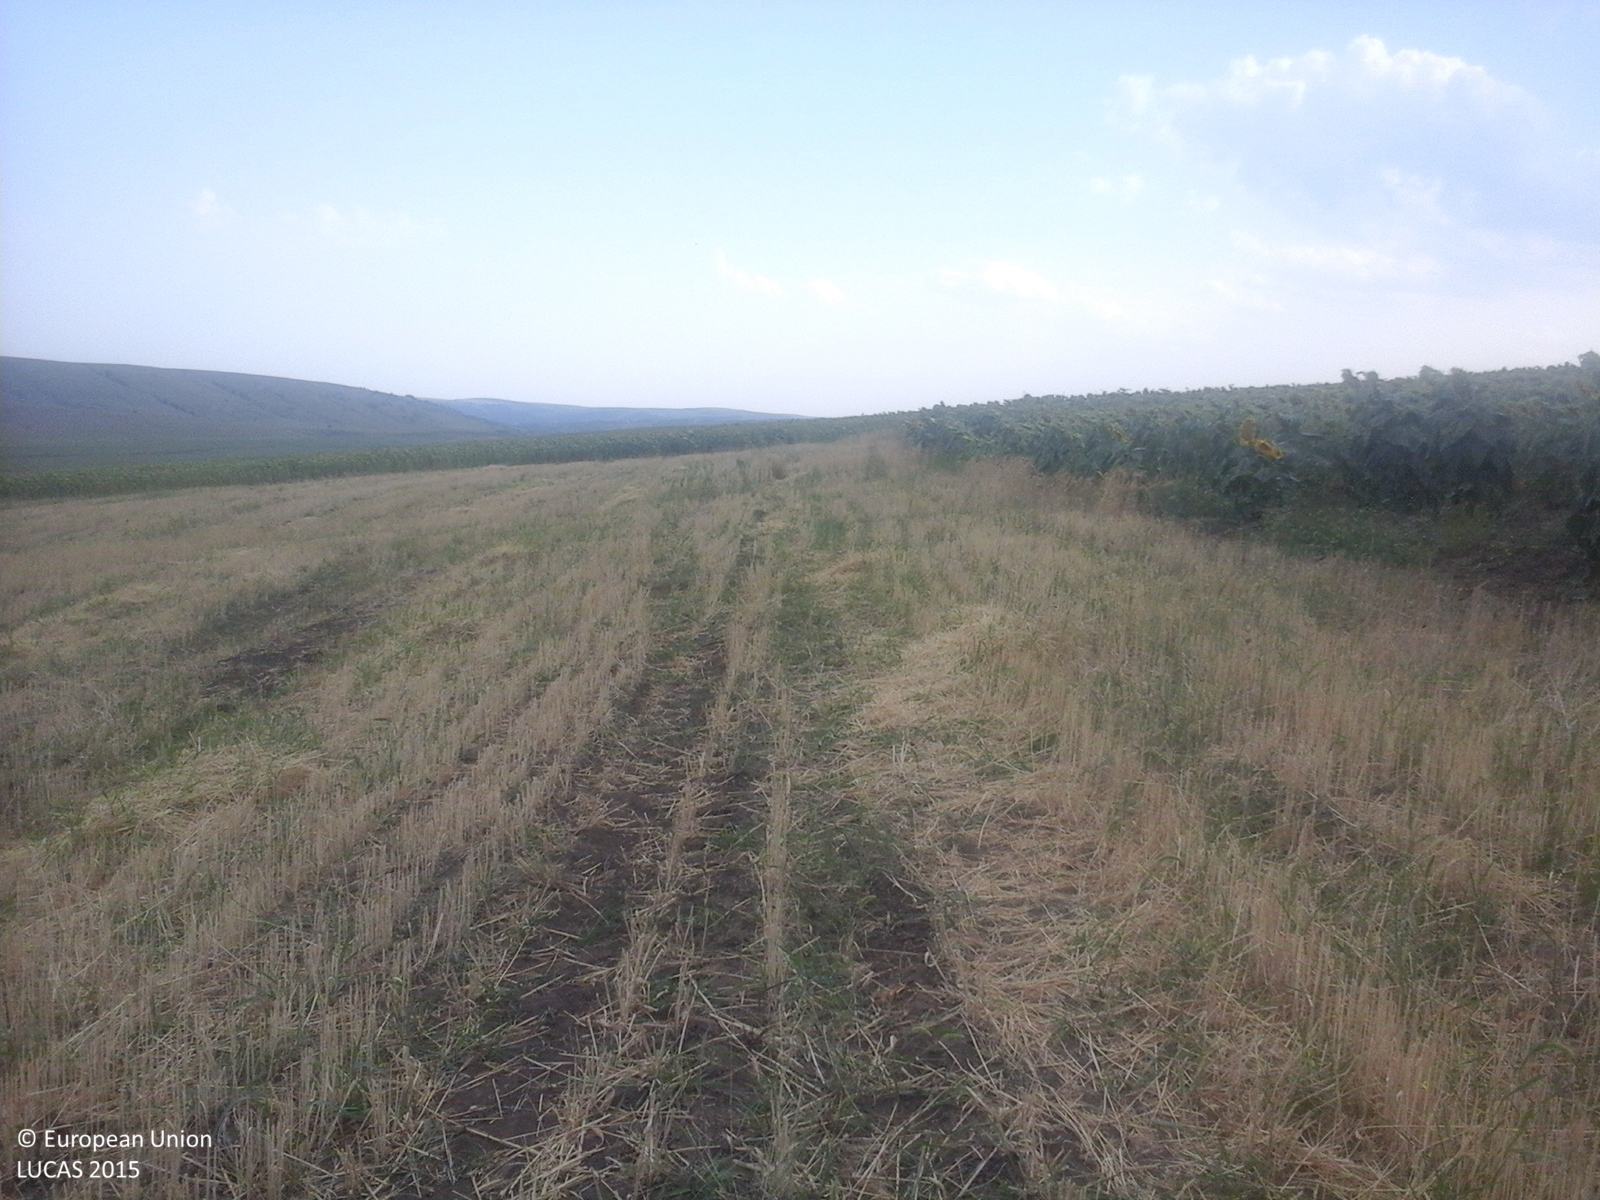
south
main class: Cropland
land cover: Common wheat
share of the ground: 50 - 75 %
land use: Agriculture (excluding fallow land and kitchen gardens)
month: July
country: RO
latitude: 45.8438
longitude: 27.9795
